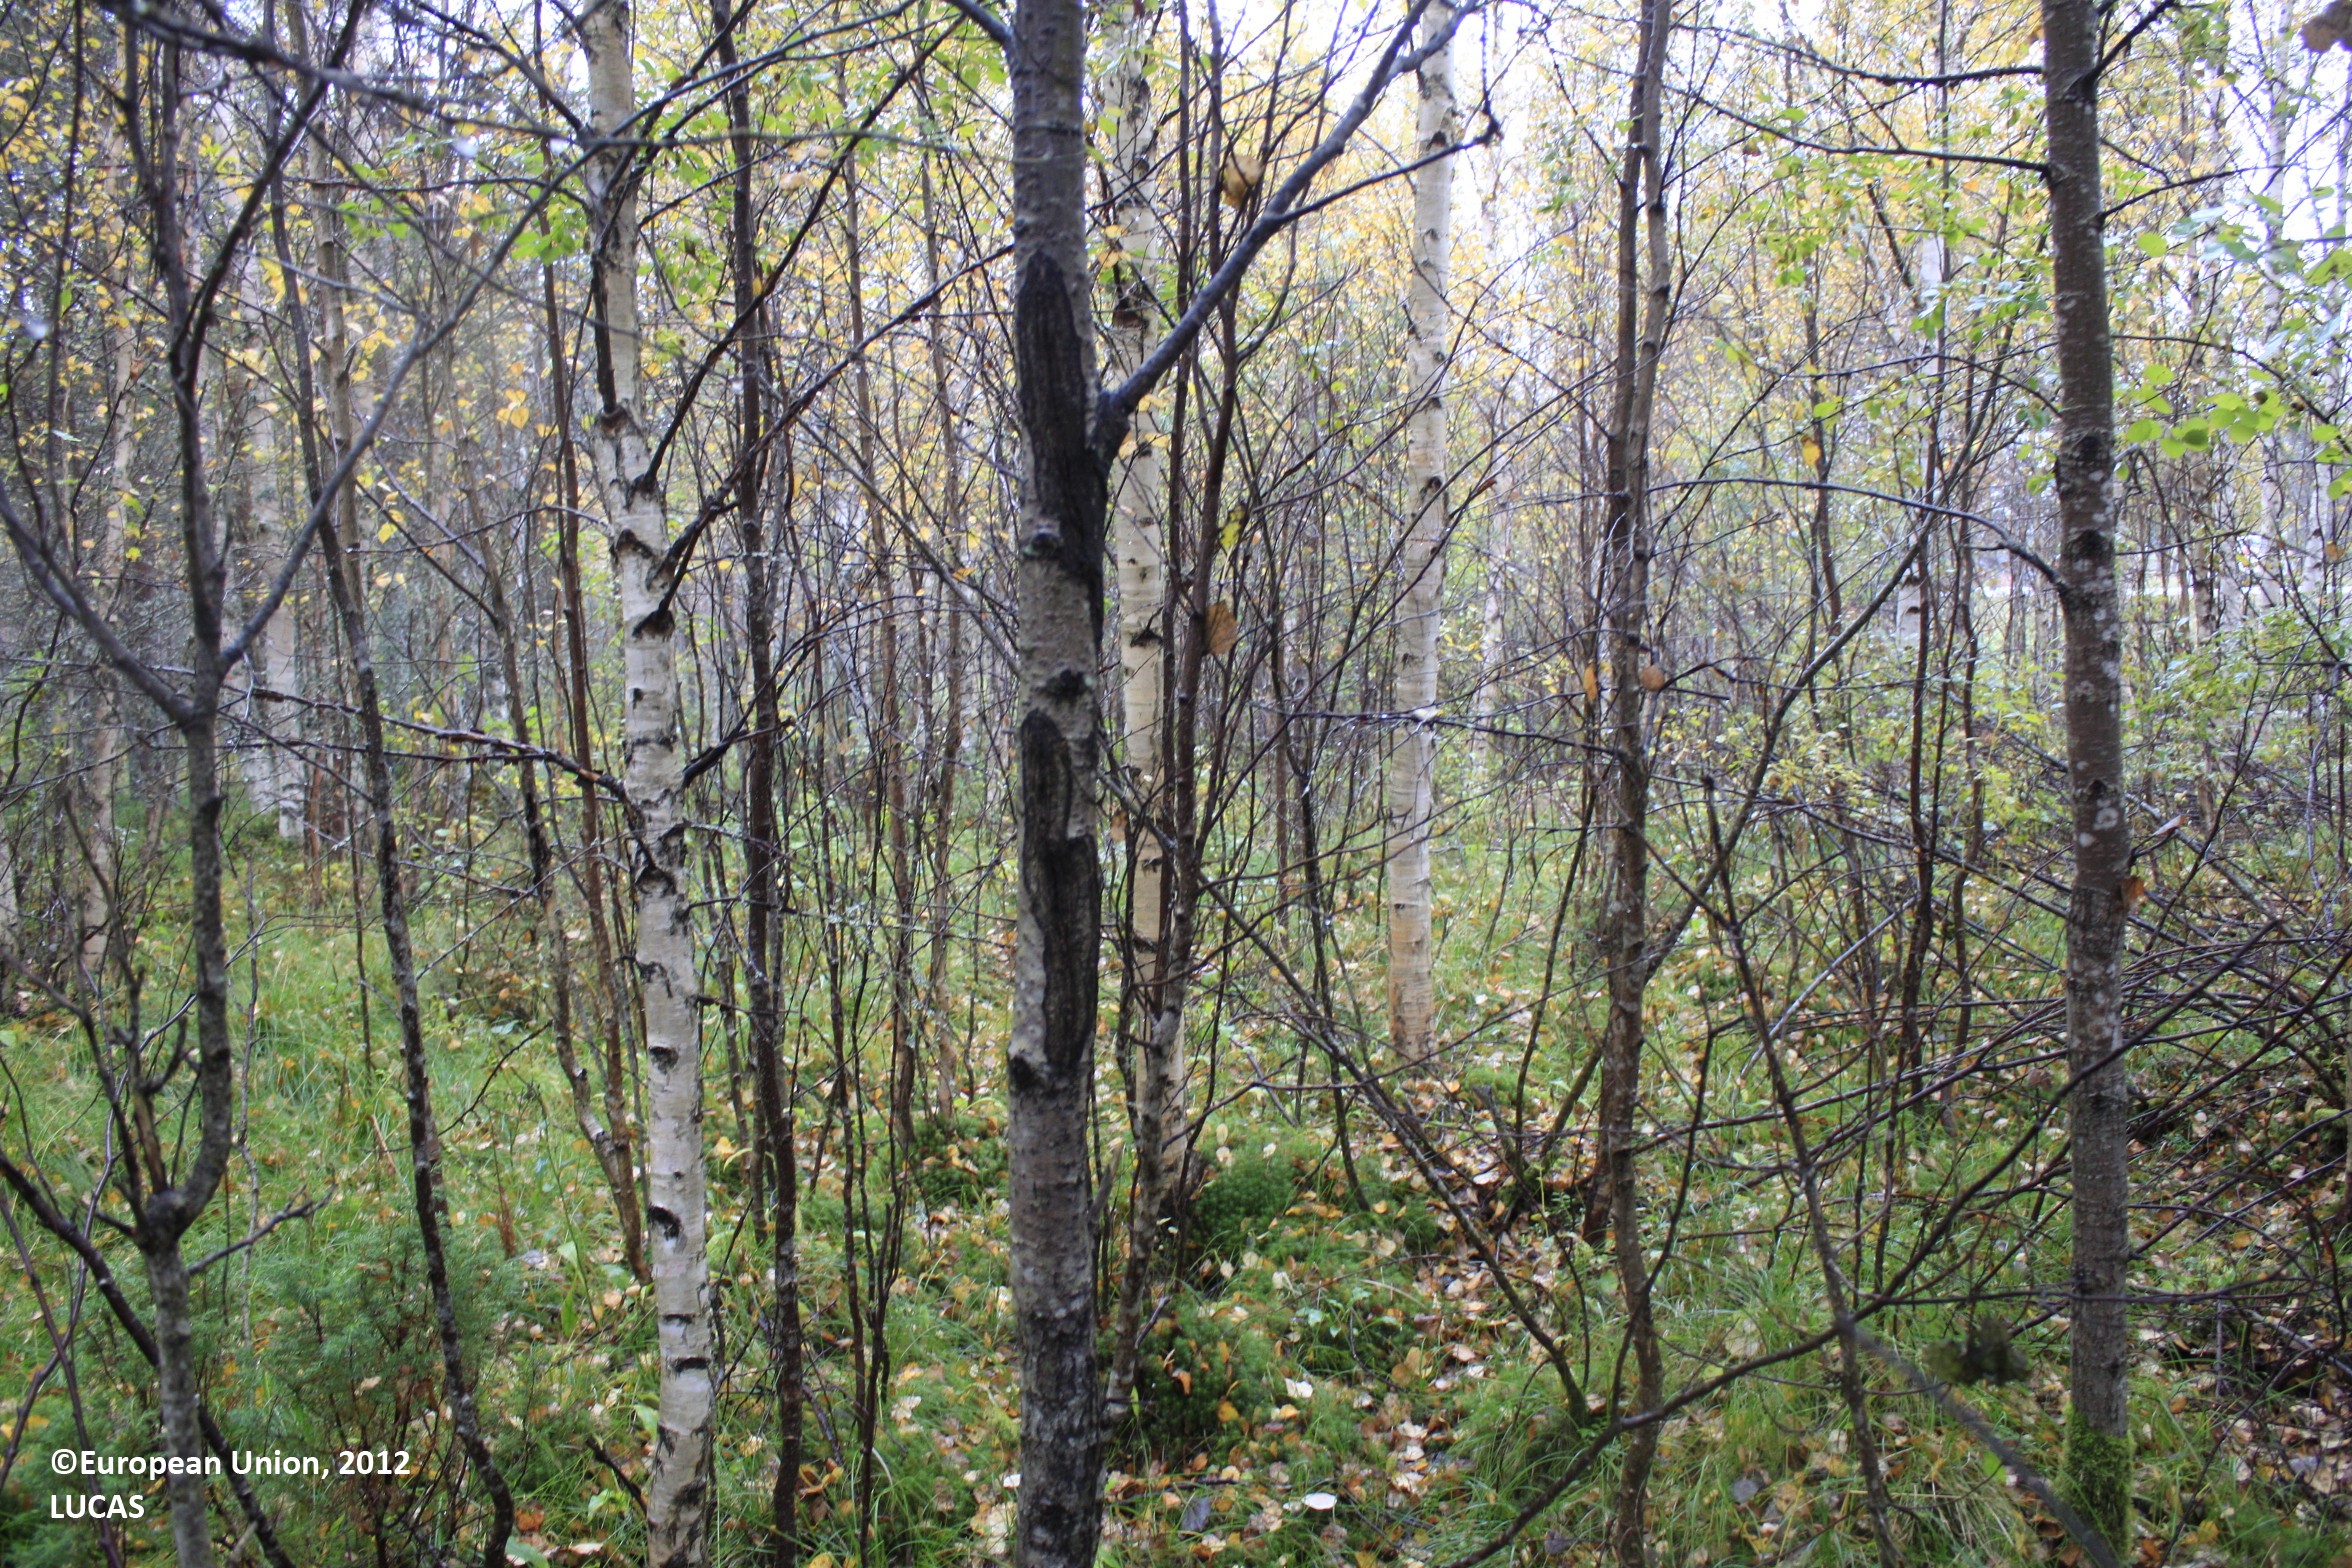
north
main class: Woodland
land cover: Broadleaved woodland
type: boreal forest
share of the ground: > 75 %
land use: Forestry
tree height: > 5 m
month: September
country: FI
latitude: 65.6406
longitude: 27.3981
